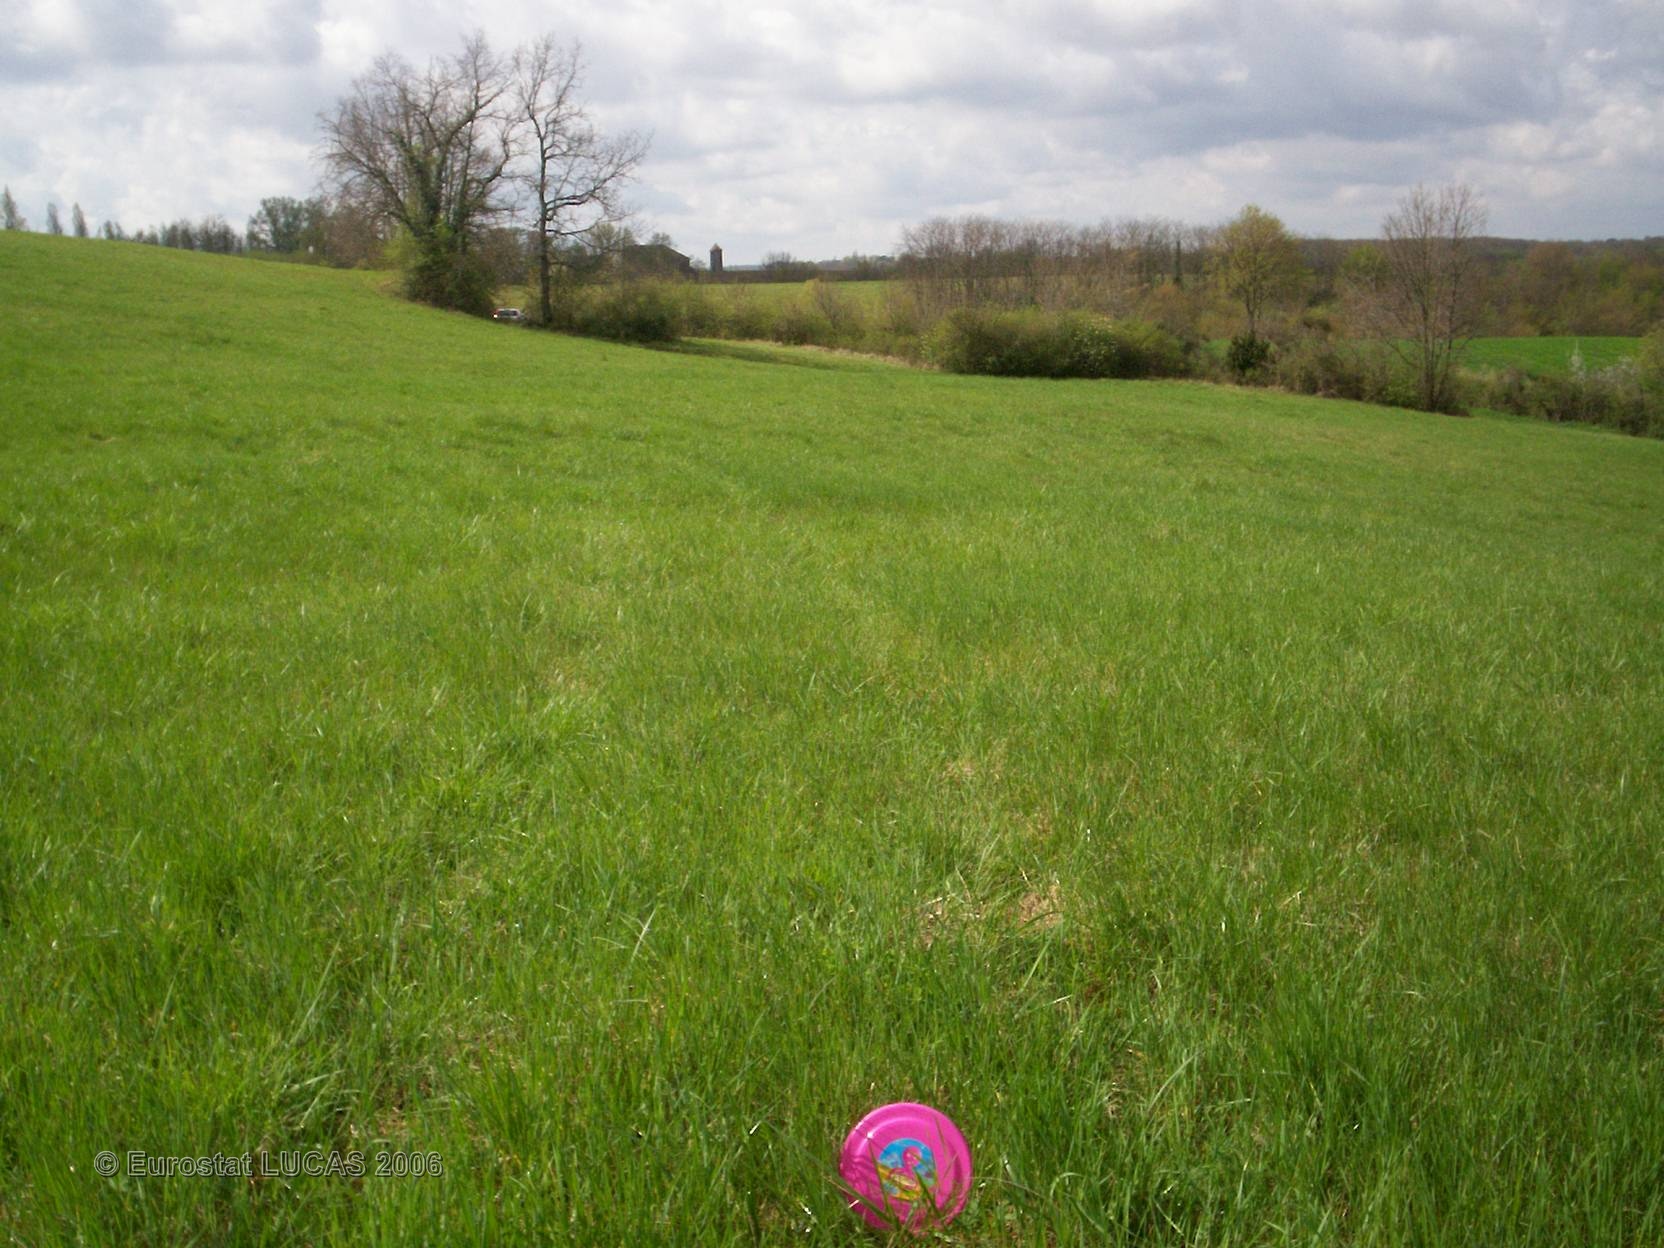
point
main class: Grassland
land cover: Grassland without tree/shrub cover
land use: Agriculture (excluding fallow land and kitchen gardens)
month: April
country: FR
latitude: 43.9701
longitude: 0.1332
